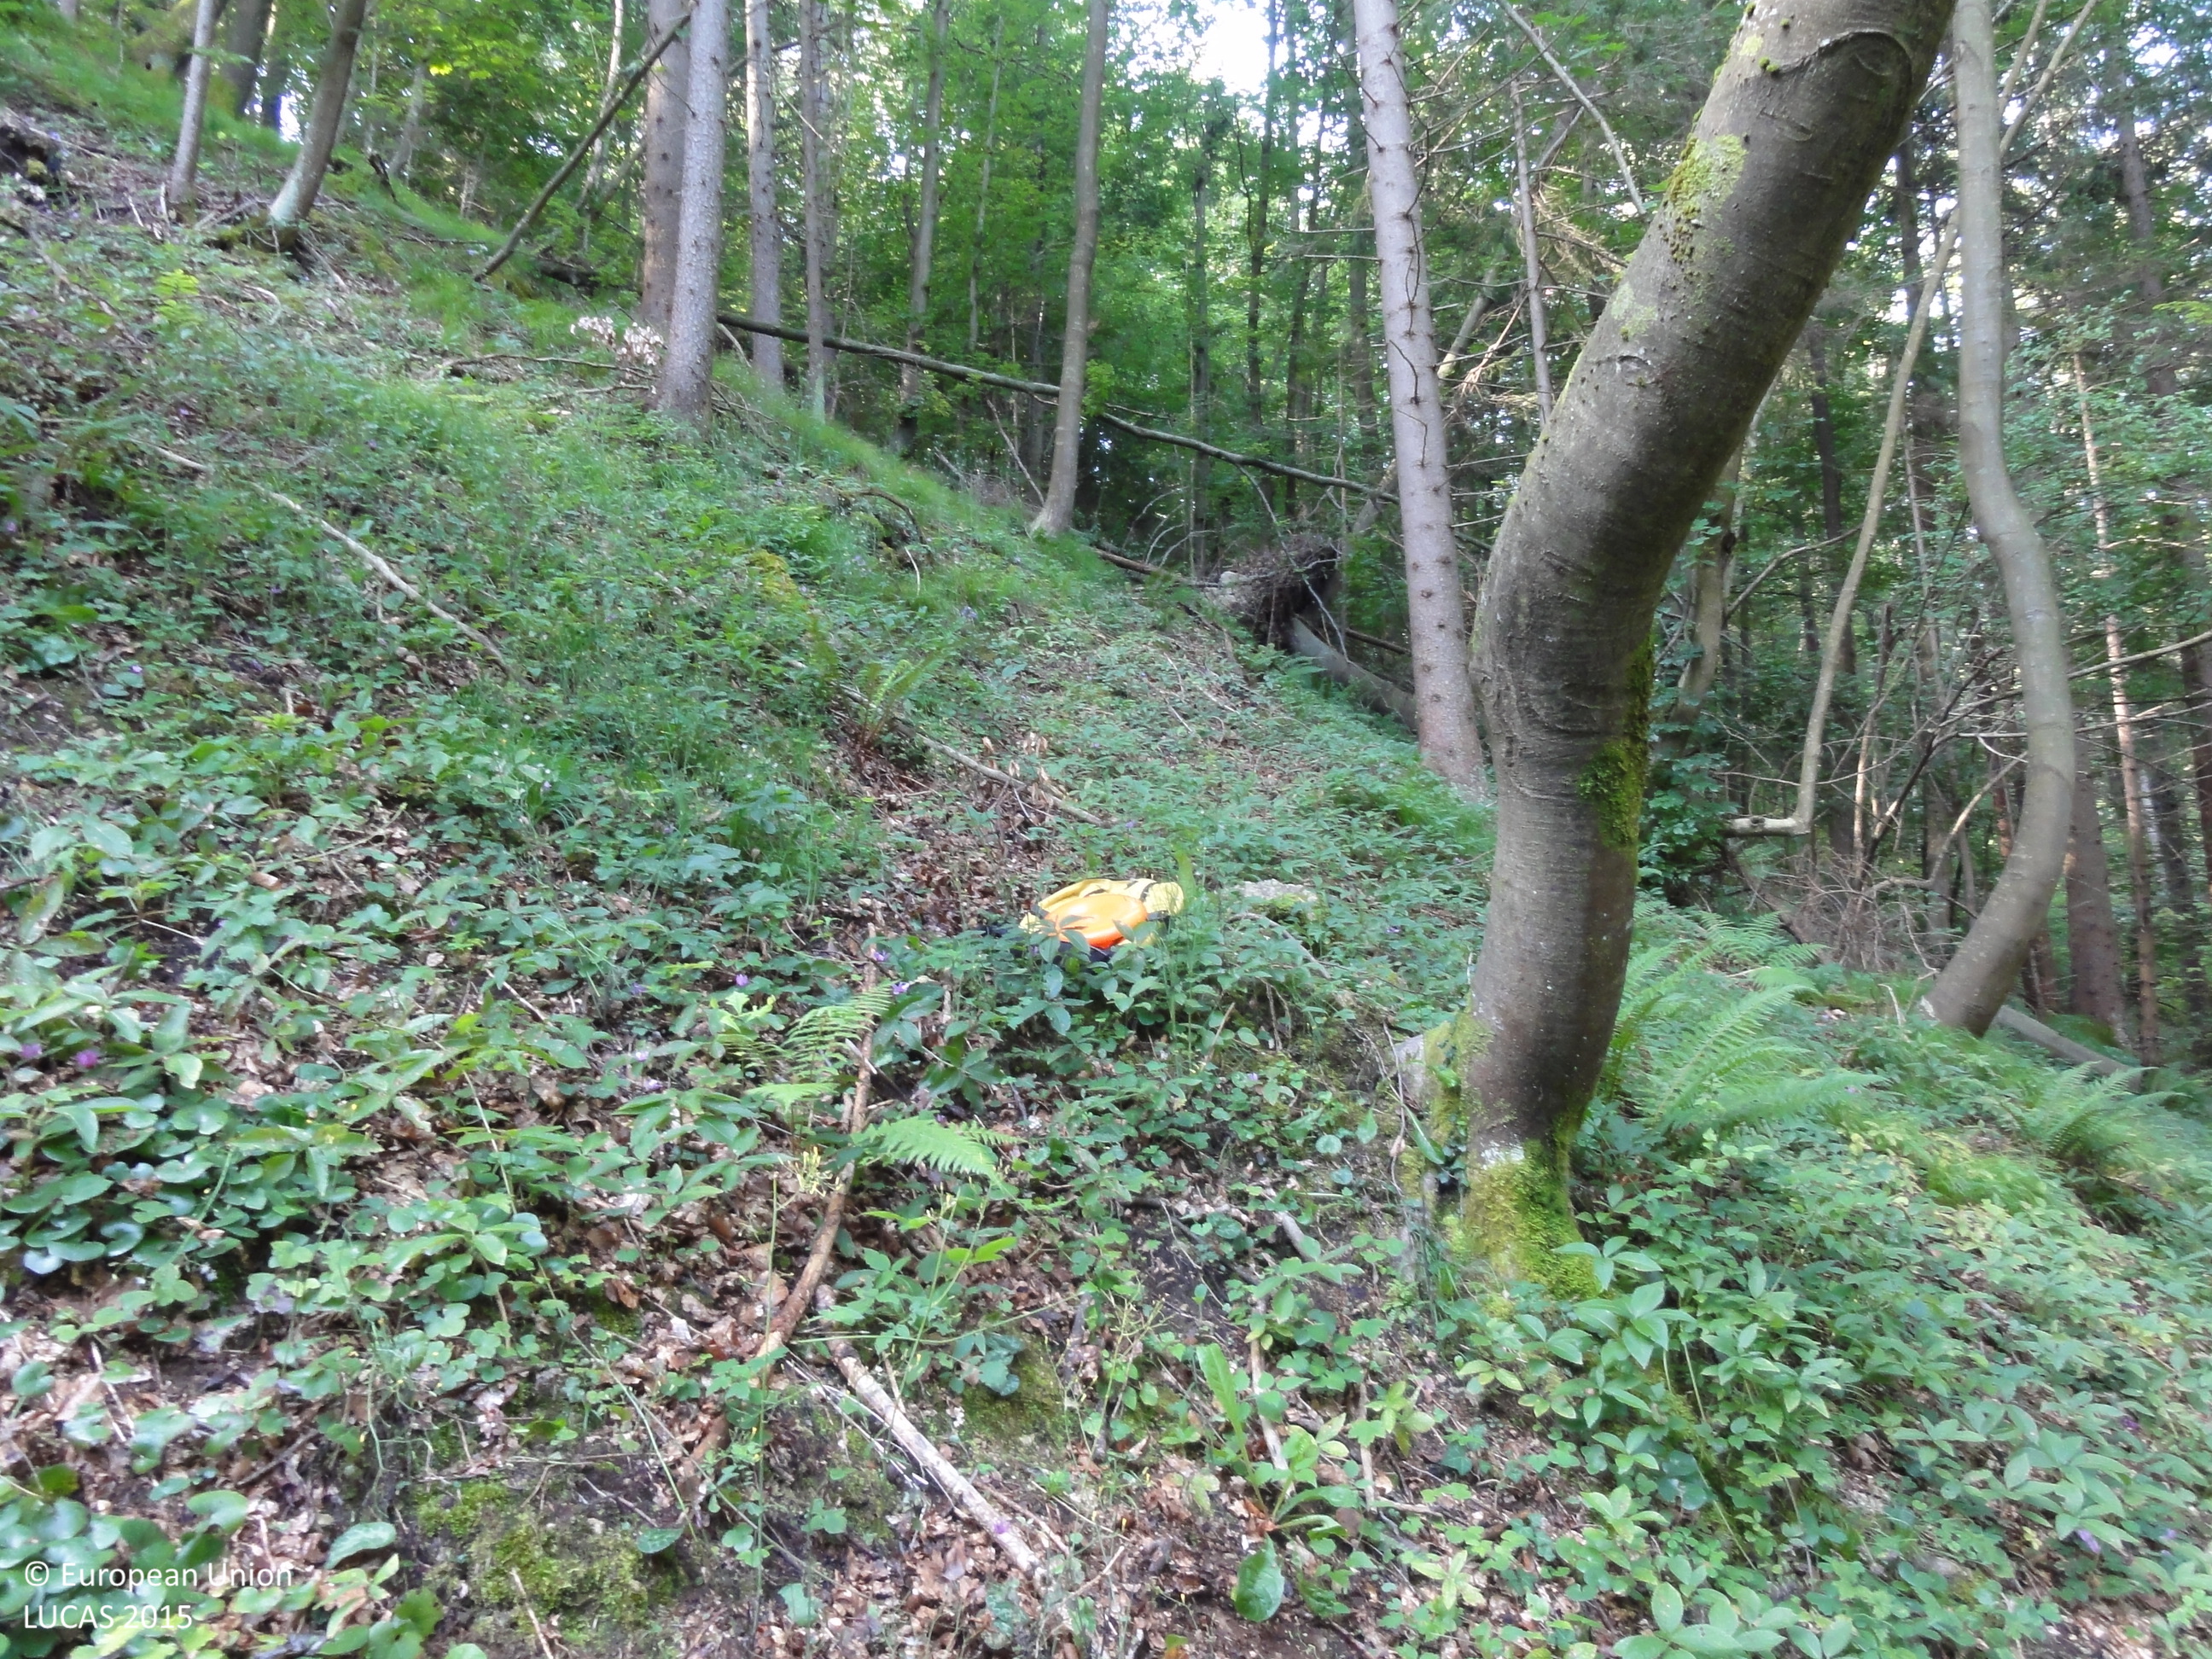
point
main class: Woodland
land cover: Spruce dominated mixed woodland
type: mountainous beech forest
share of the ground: > 75 %
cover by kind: broadleaved forest trees 50 %, coniferous forest trees 25 %, herbaceous plants 20 %, shrubs 5 %
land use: Forestry
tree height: > 5 m
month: August
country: SI
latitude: 46.3173
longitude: 15.1535
